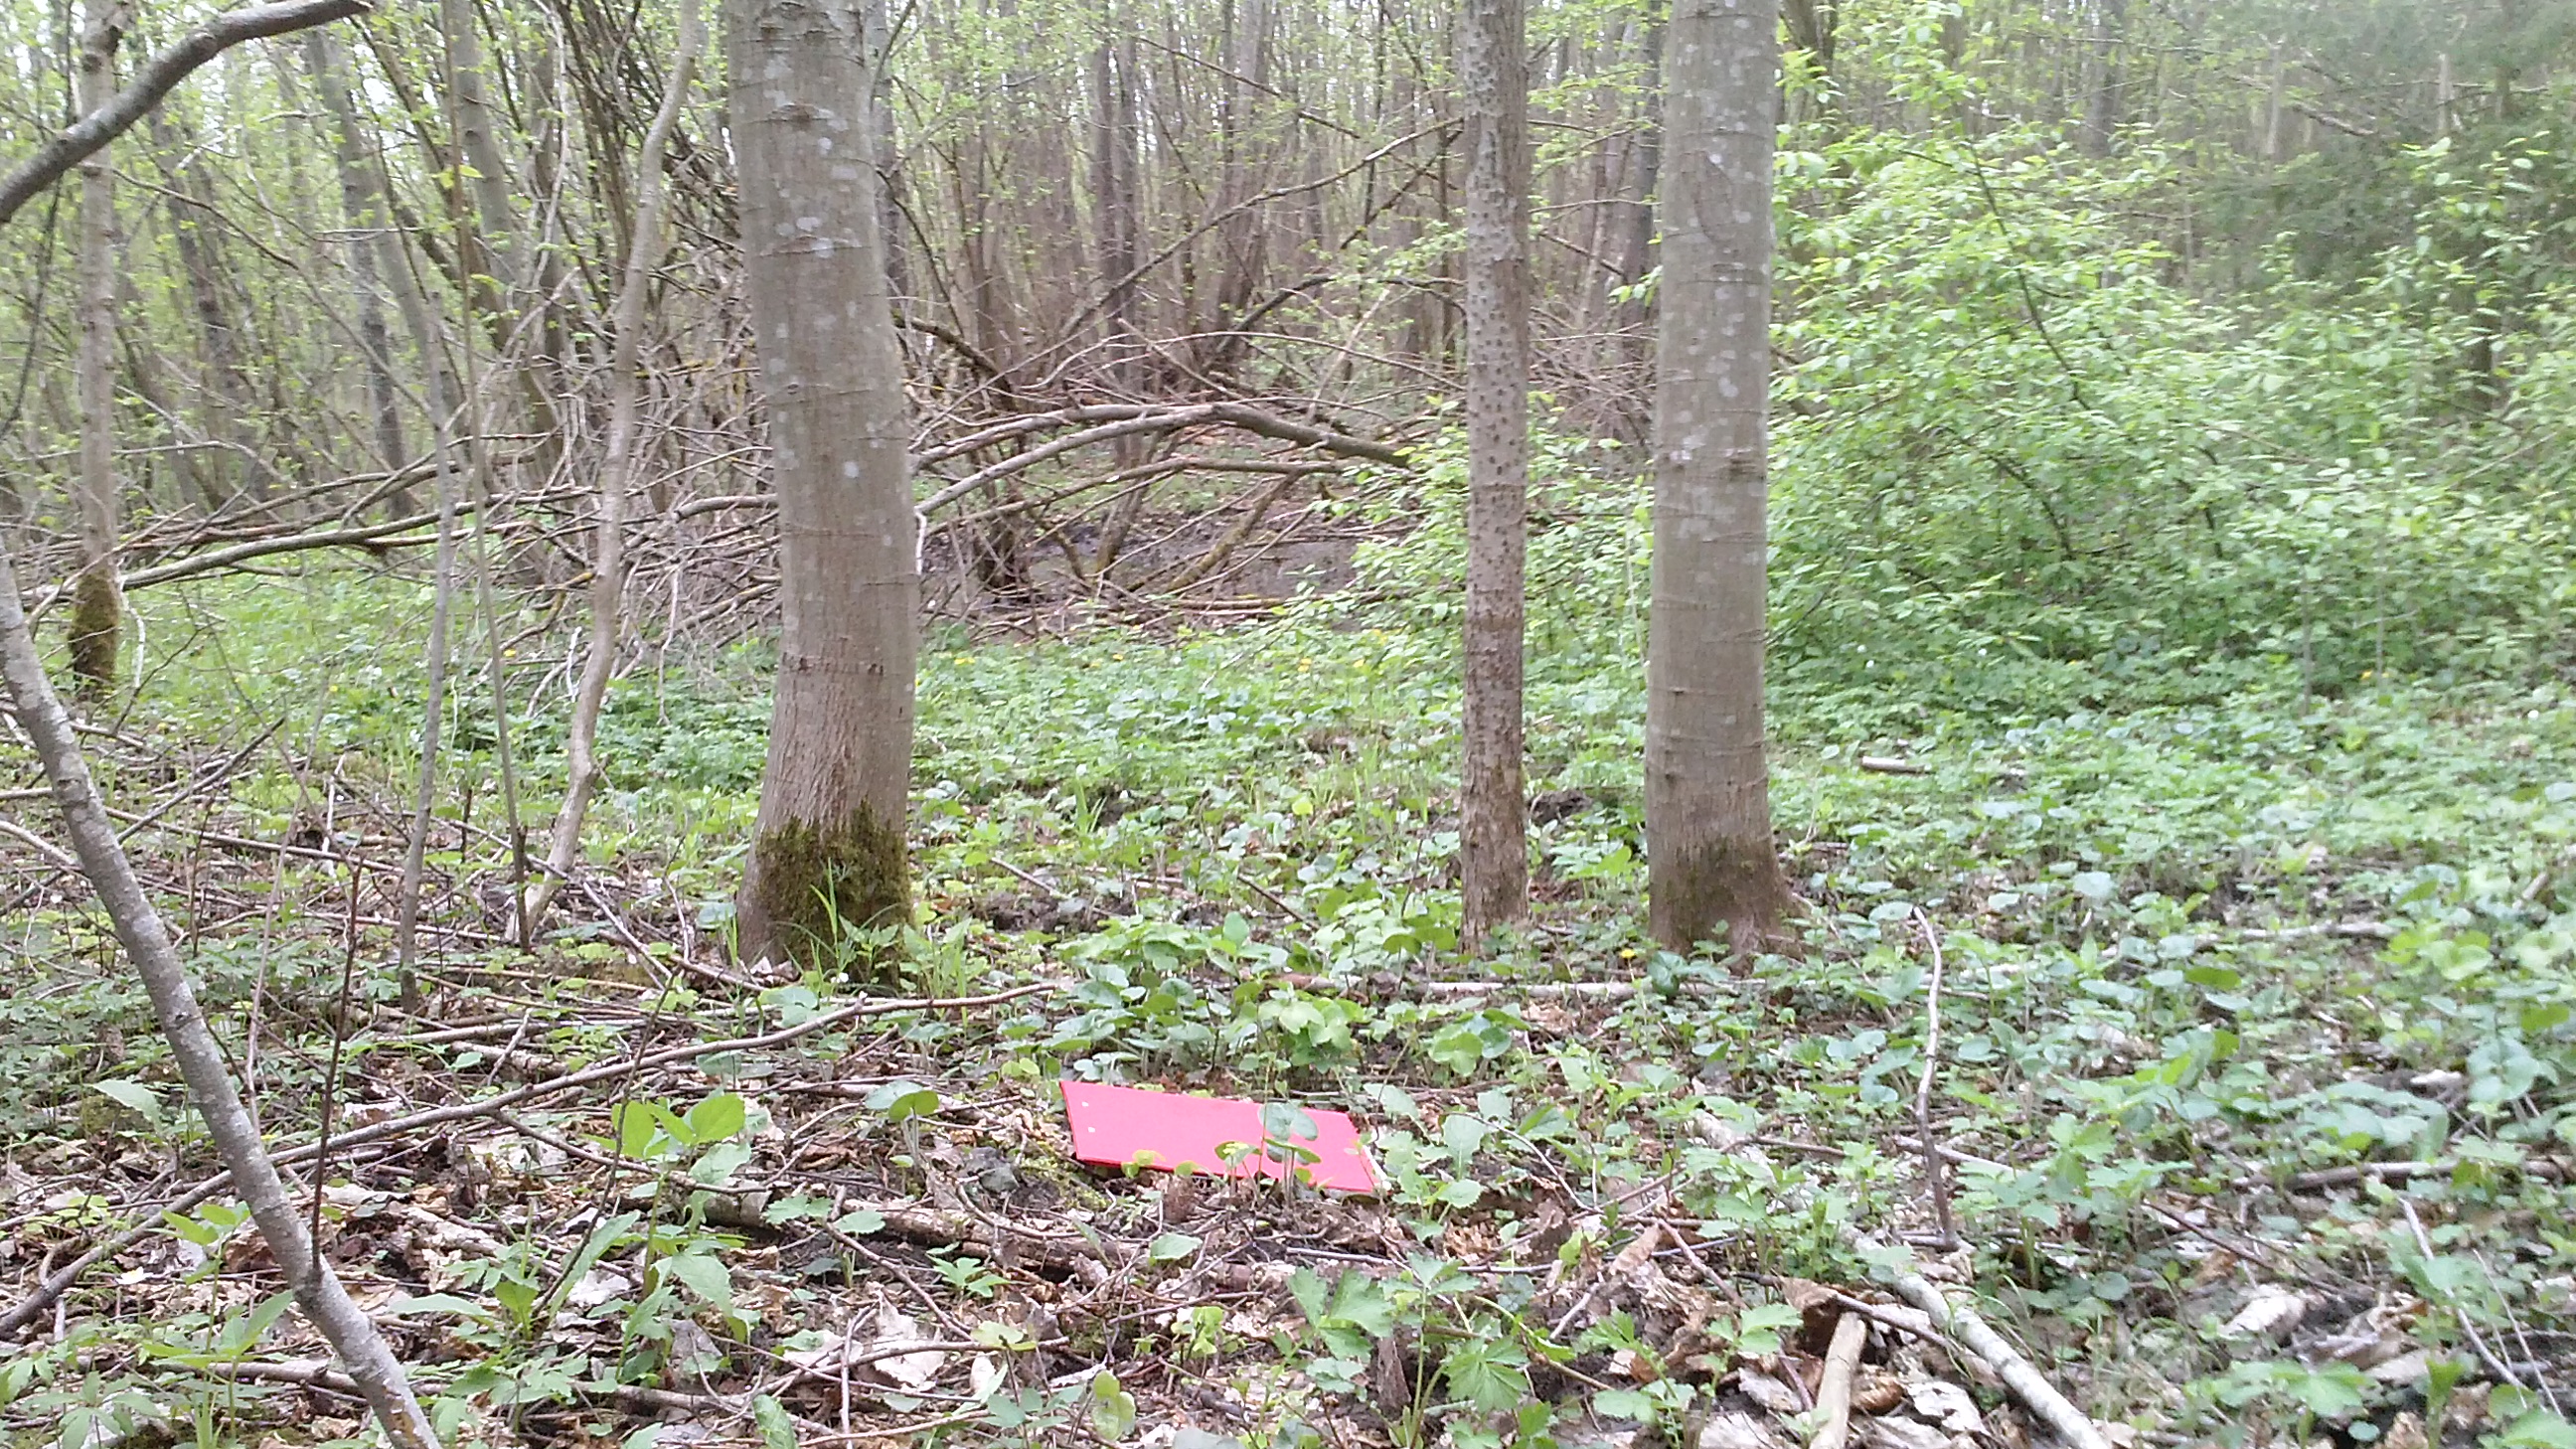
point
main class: Woodland
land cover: Broadleaved woodland
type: non-riverine alder, birch or aspen forest
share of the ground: > 75 %
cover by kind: broadleaved forest trees 90 %, coniferous forest trees 10 %
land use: Forestry
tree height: > 5 m
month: May
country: LV
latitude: 55.9838
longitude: 27.1106
